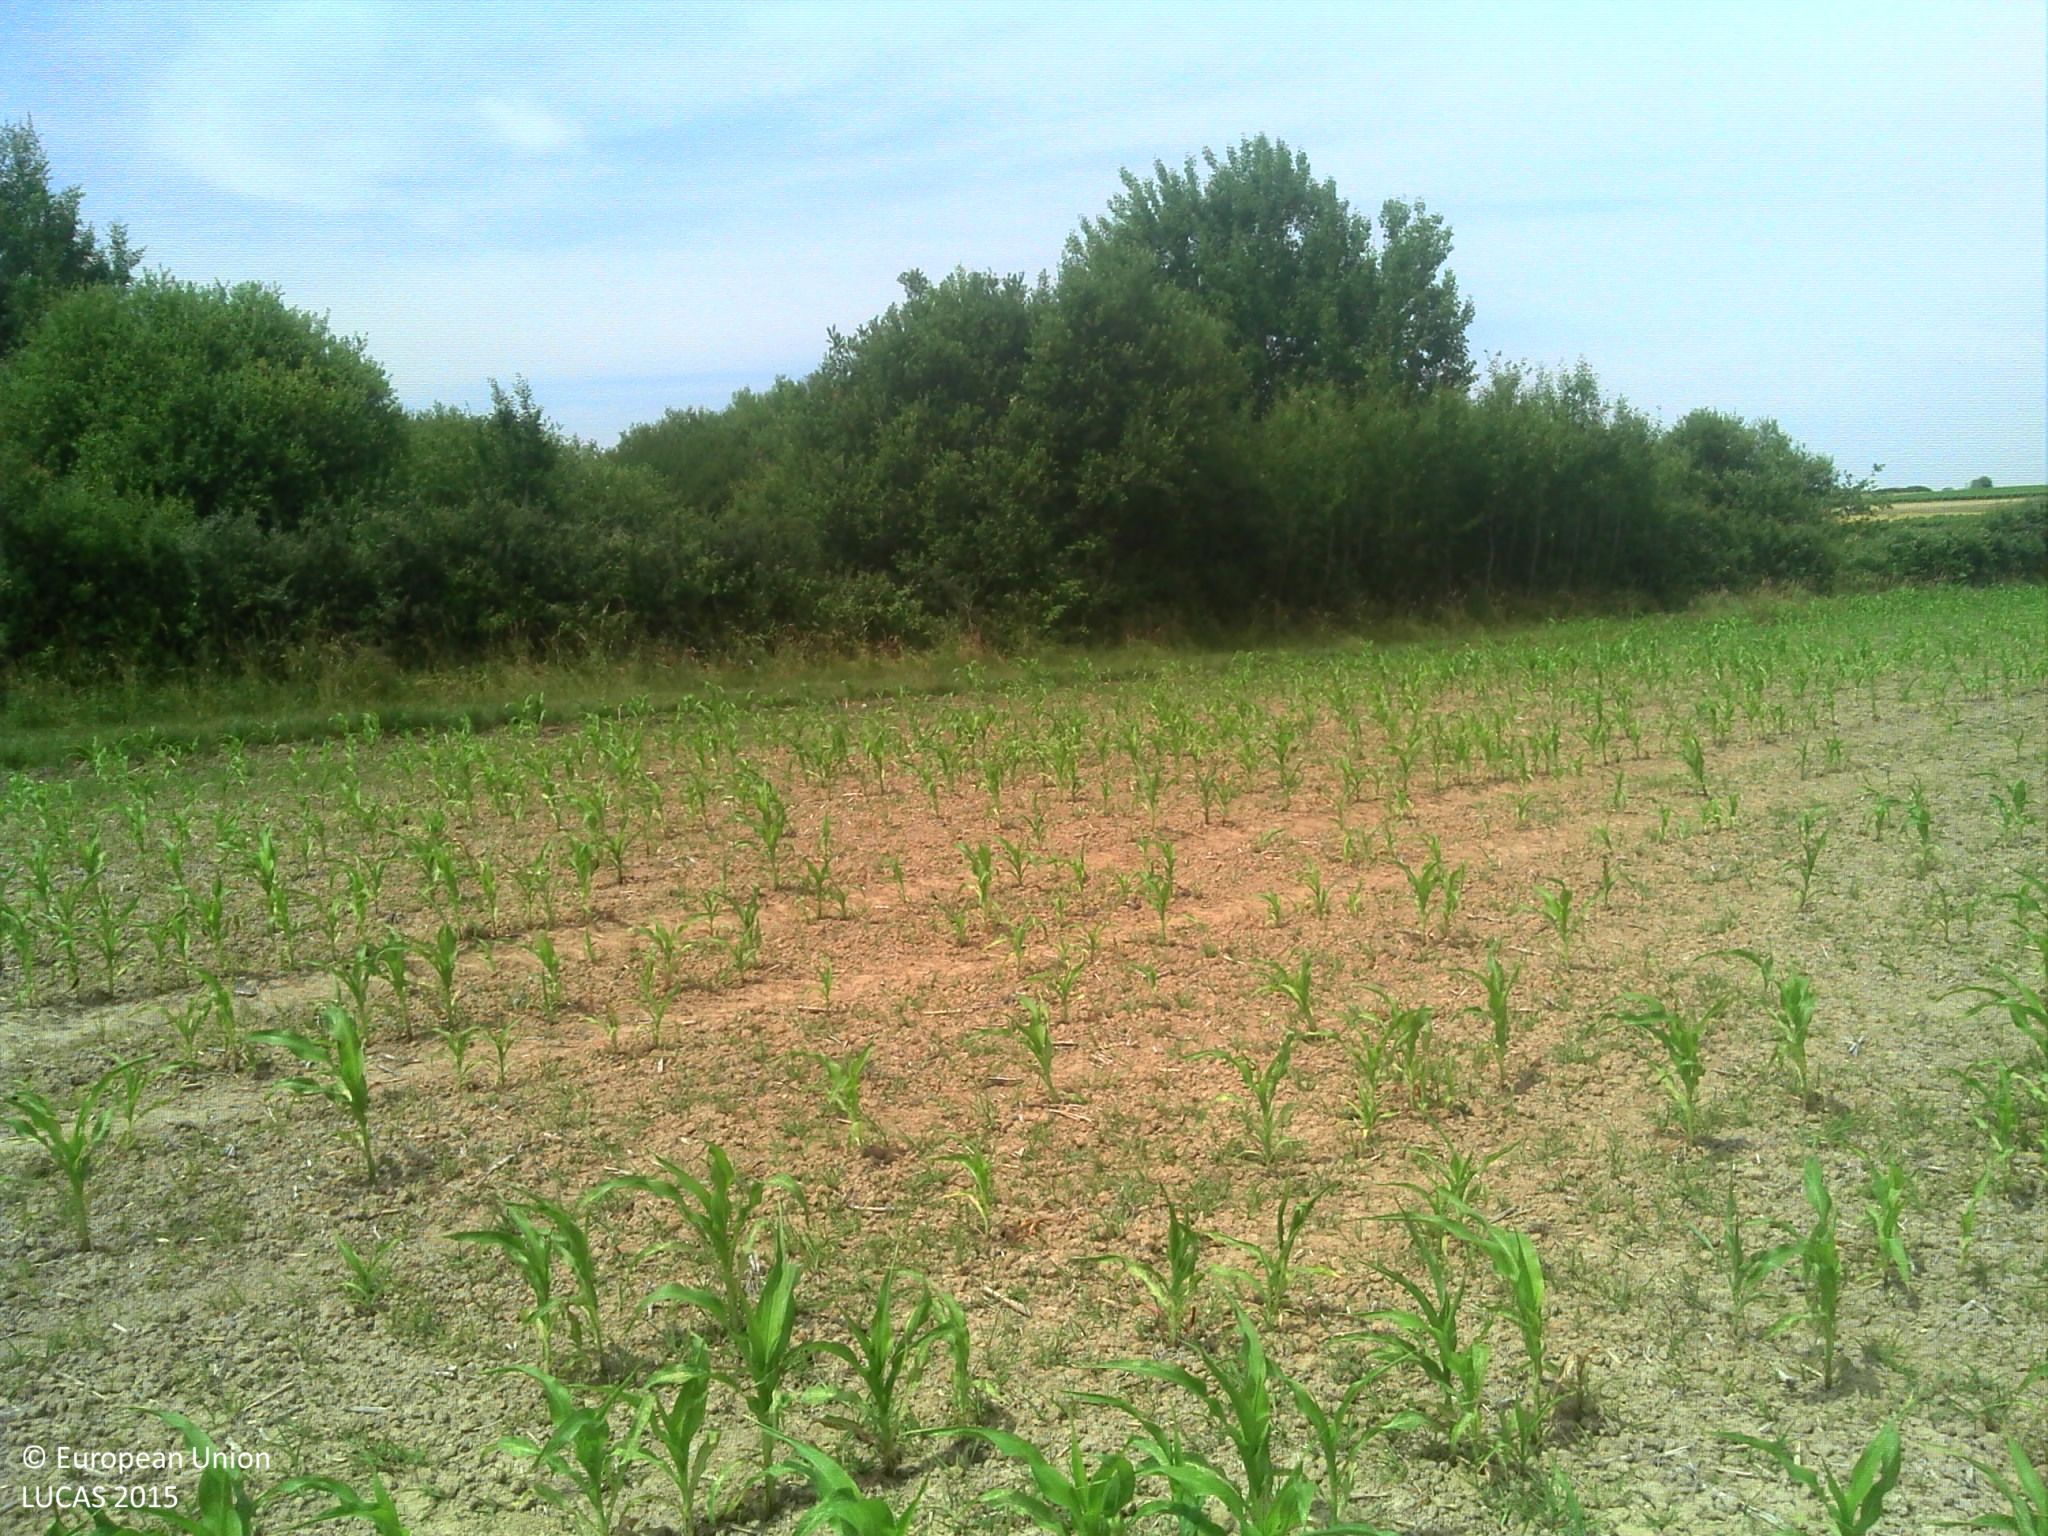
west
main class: Cropland
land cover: Maize
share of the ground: 25 - 50 %
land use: Agriculture (excluding fallow land and kitchen gardens)
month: June
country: FR
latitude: 47.4667
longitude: 1.3485
